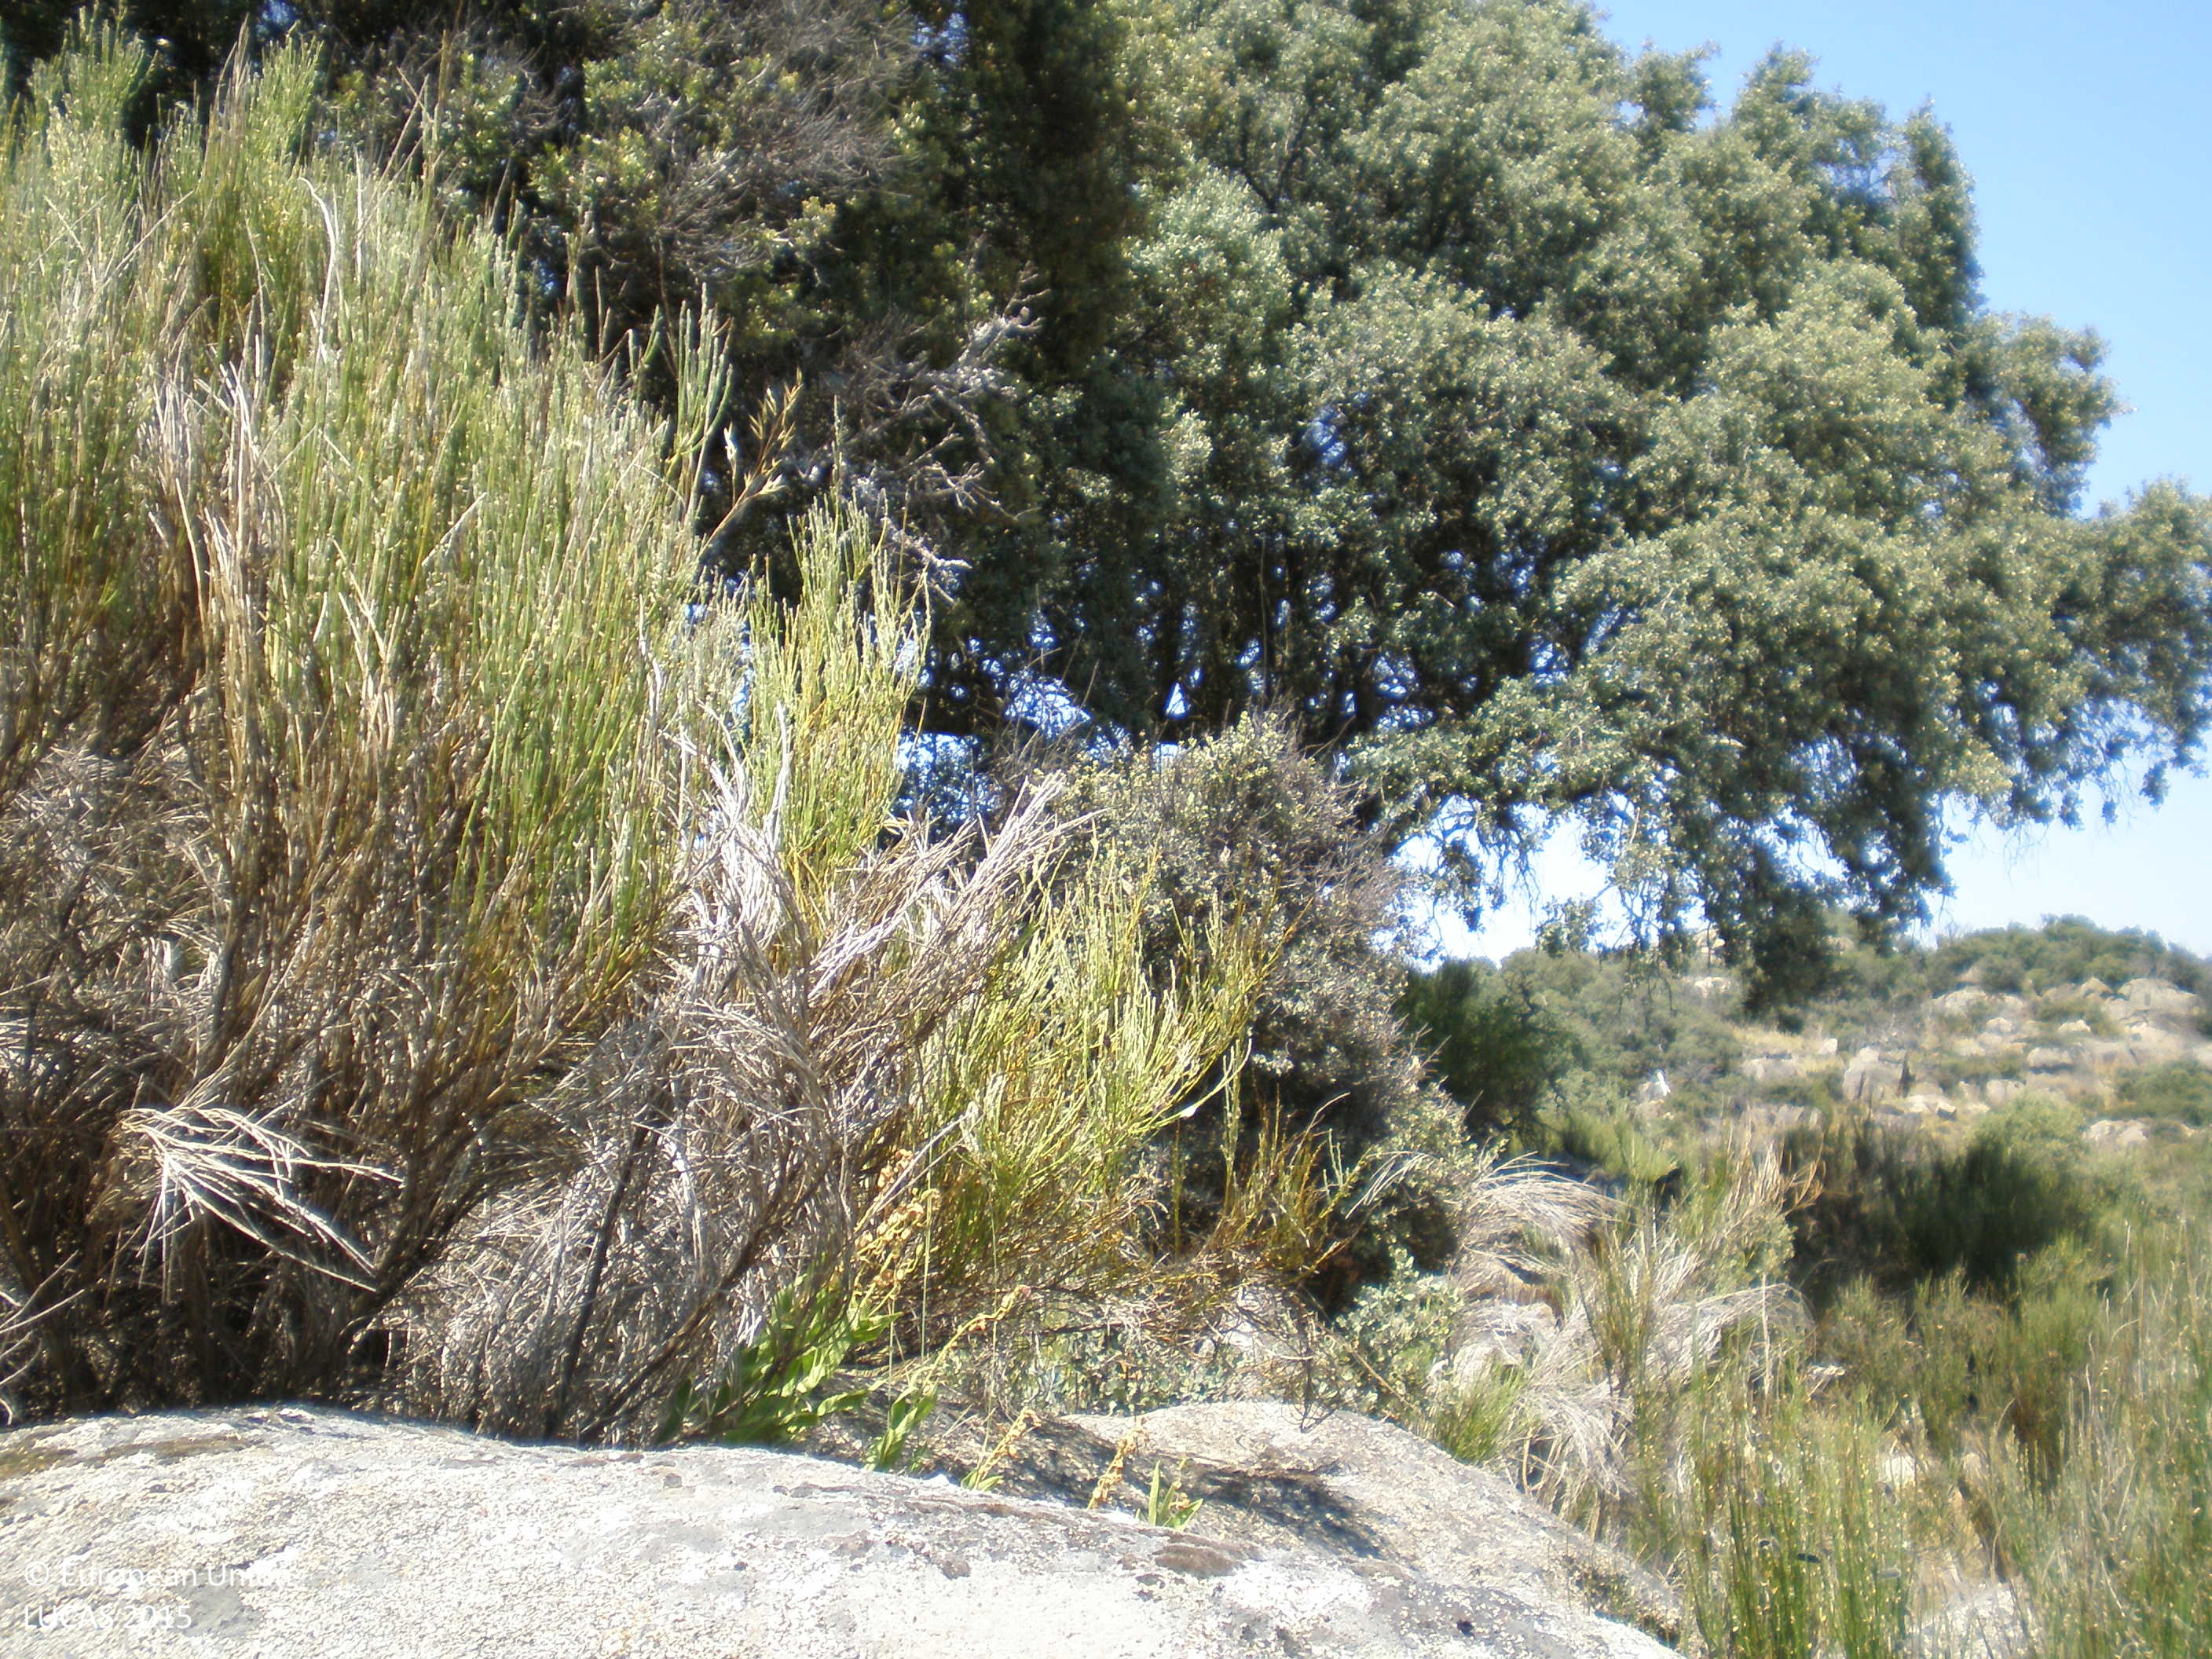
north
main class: Shrubland
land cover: Shrubland with sparse tree cover
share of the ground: 50 - 75 %
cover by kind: shrubs 60 %, herbaceous plants 20 %, consolidated bare surface 15 %, broadleaved forest trees 5 %
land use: Agriculture (excluding fallow land and kitchen gardens)
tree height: < 5 m
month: July
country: ES
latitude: 40.4277
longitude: -5.5916
